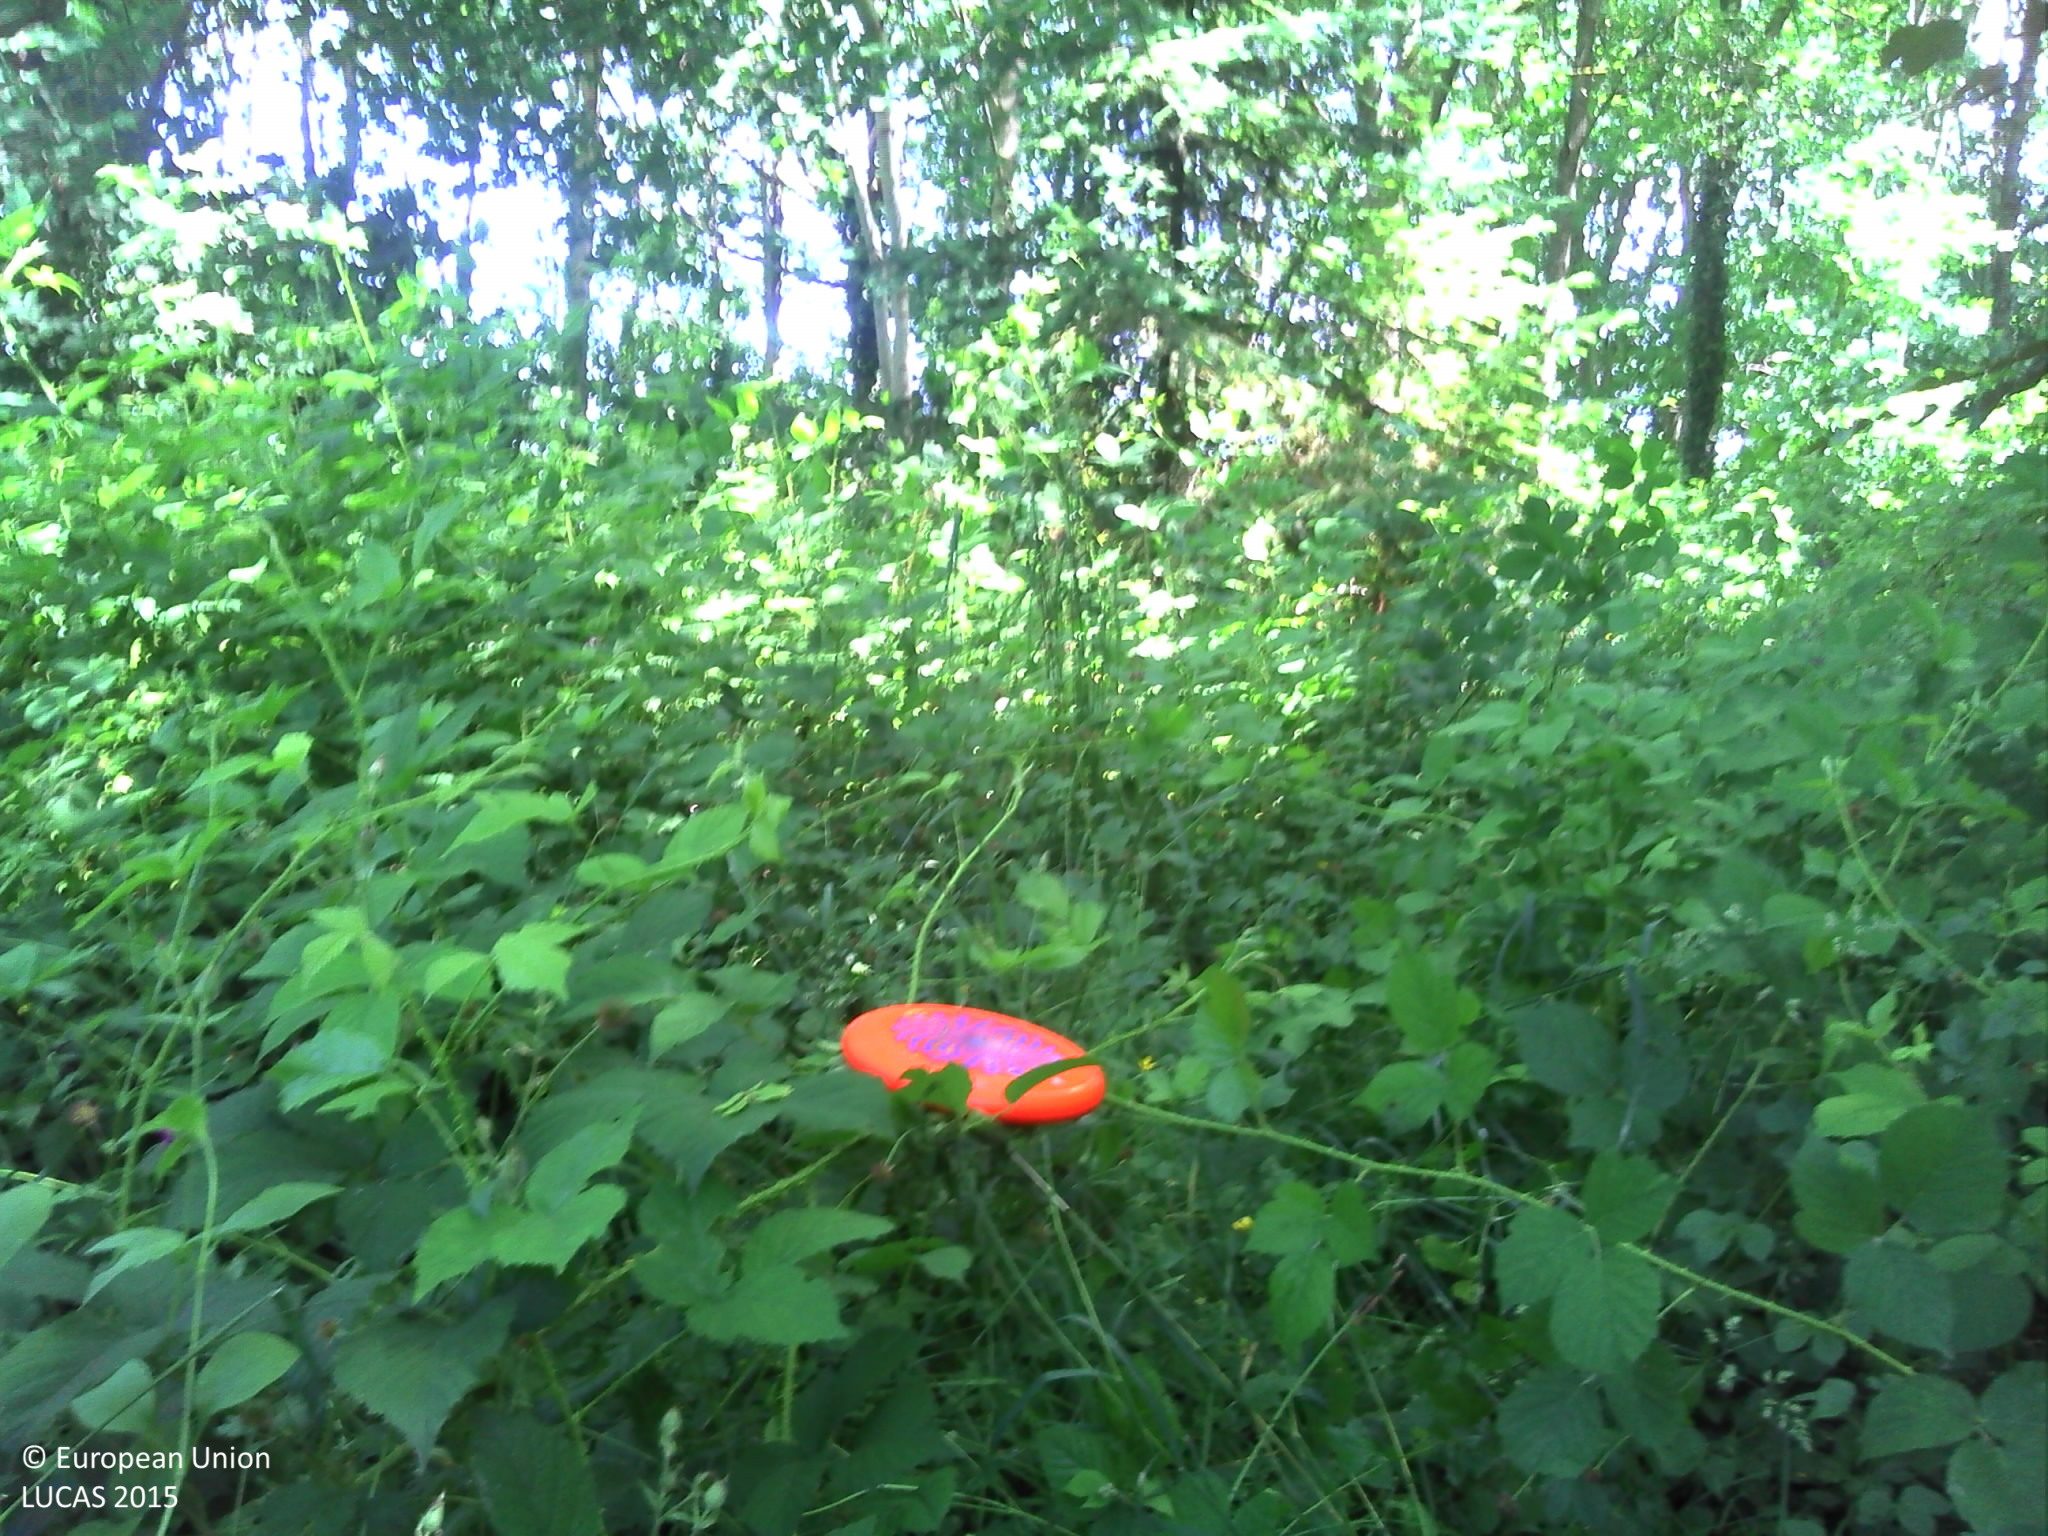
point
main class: Woodland
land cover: Other mixed woodland
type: hemiboreal forest and nemoral coniferous forest and mixed broadleaved-coniferous forest
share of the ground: > 75 %
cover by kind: broadleaved forest trees 55 %, coniferous forest trees 25 %, shrubs 15 %, lichens and mosses 5 %
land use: Semi-natural and natural areas not in use
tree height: > 5 m
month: June
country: FR
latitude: 48.6075
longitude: -0.1352
